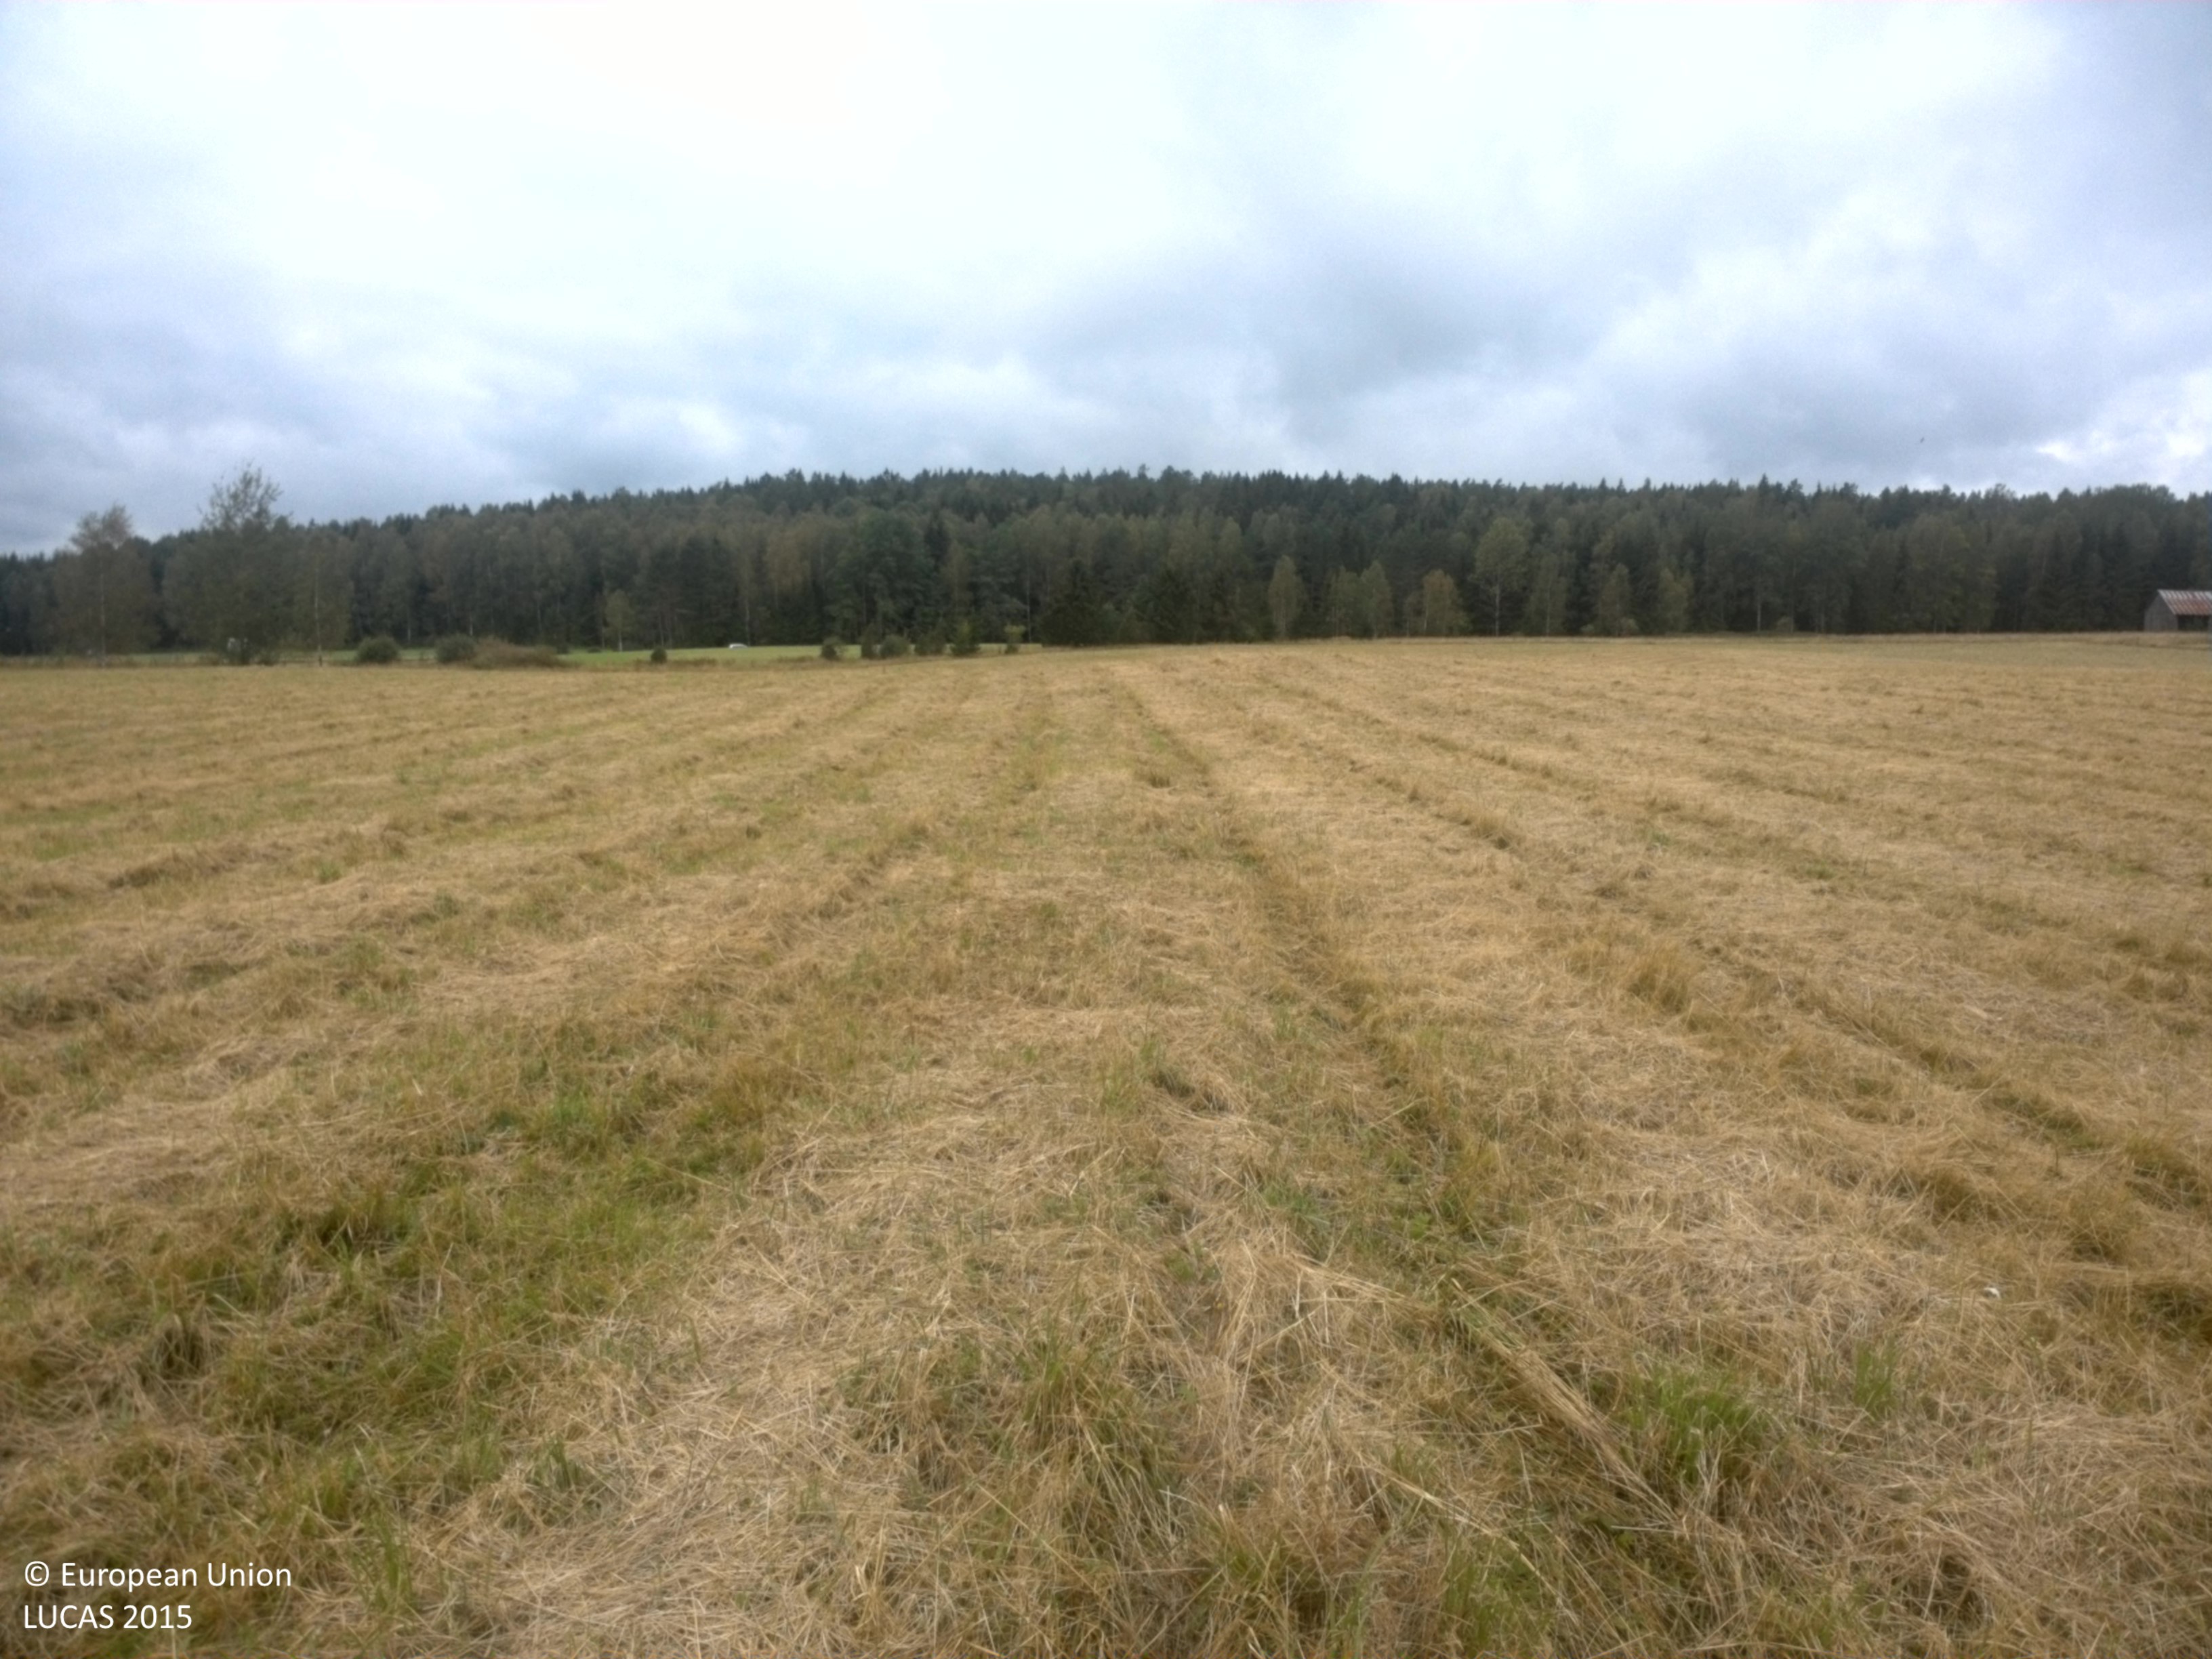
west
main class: Grassland
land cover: Grassland without tree/shrub cover
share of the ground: > 75 %
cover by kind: herbaceous plants 90 %, consolidated bare surface 10 %
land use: Agriculture (excluding fallow land and kitchen gardens)
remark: Harvested field
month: August
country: SE
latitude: 59.6048
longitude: 13.1639
